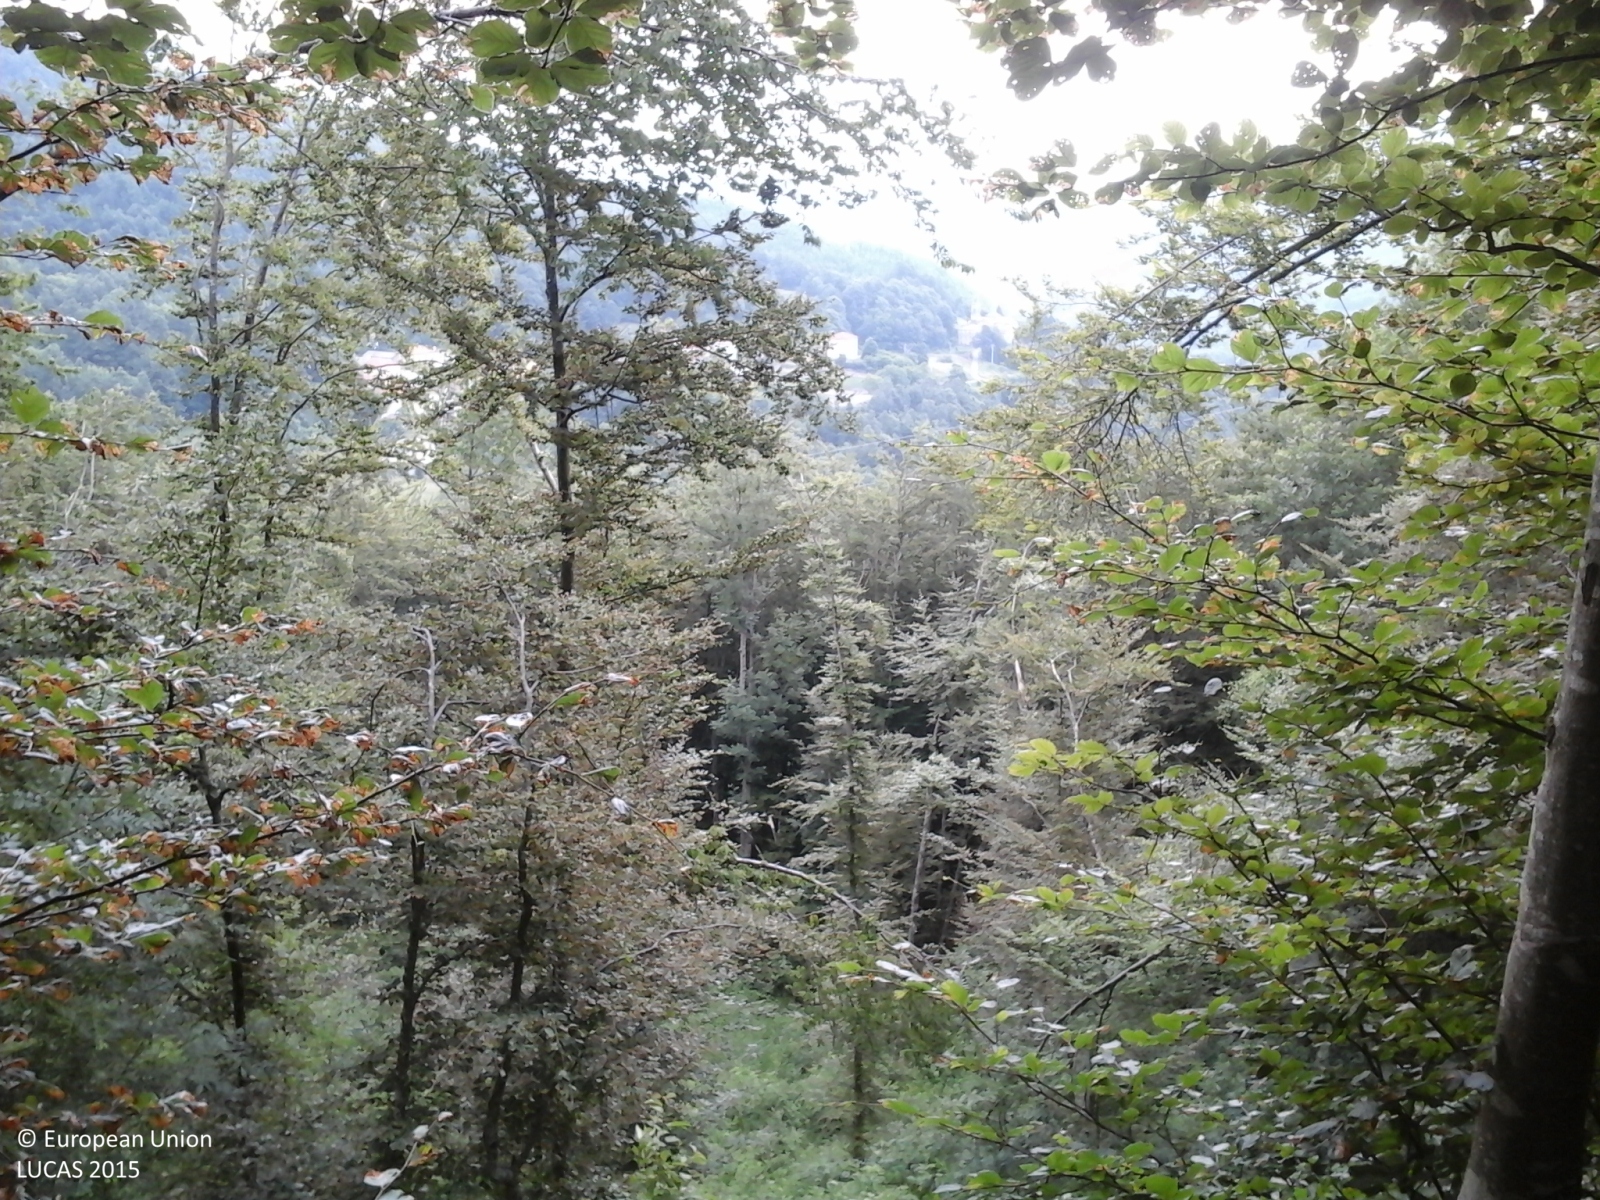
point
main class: Woodland
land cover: Broadleaved woodland
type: thermophilous deciduous forest
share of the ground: > 75 %
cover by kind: broadleaved forest trees 100 %
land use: Forestry
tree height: > 5 m
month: June
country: IT
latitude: 44.5660
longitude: 9.5603
